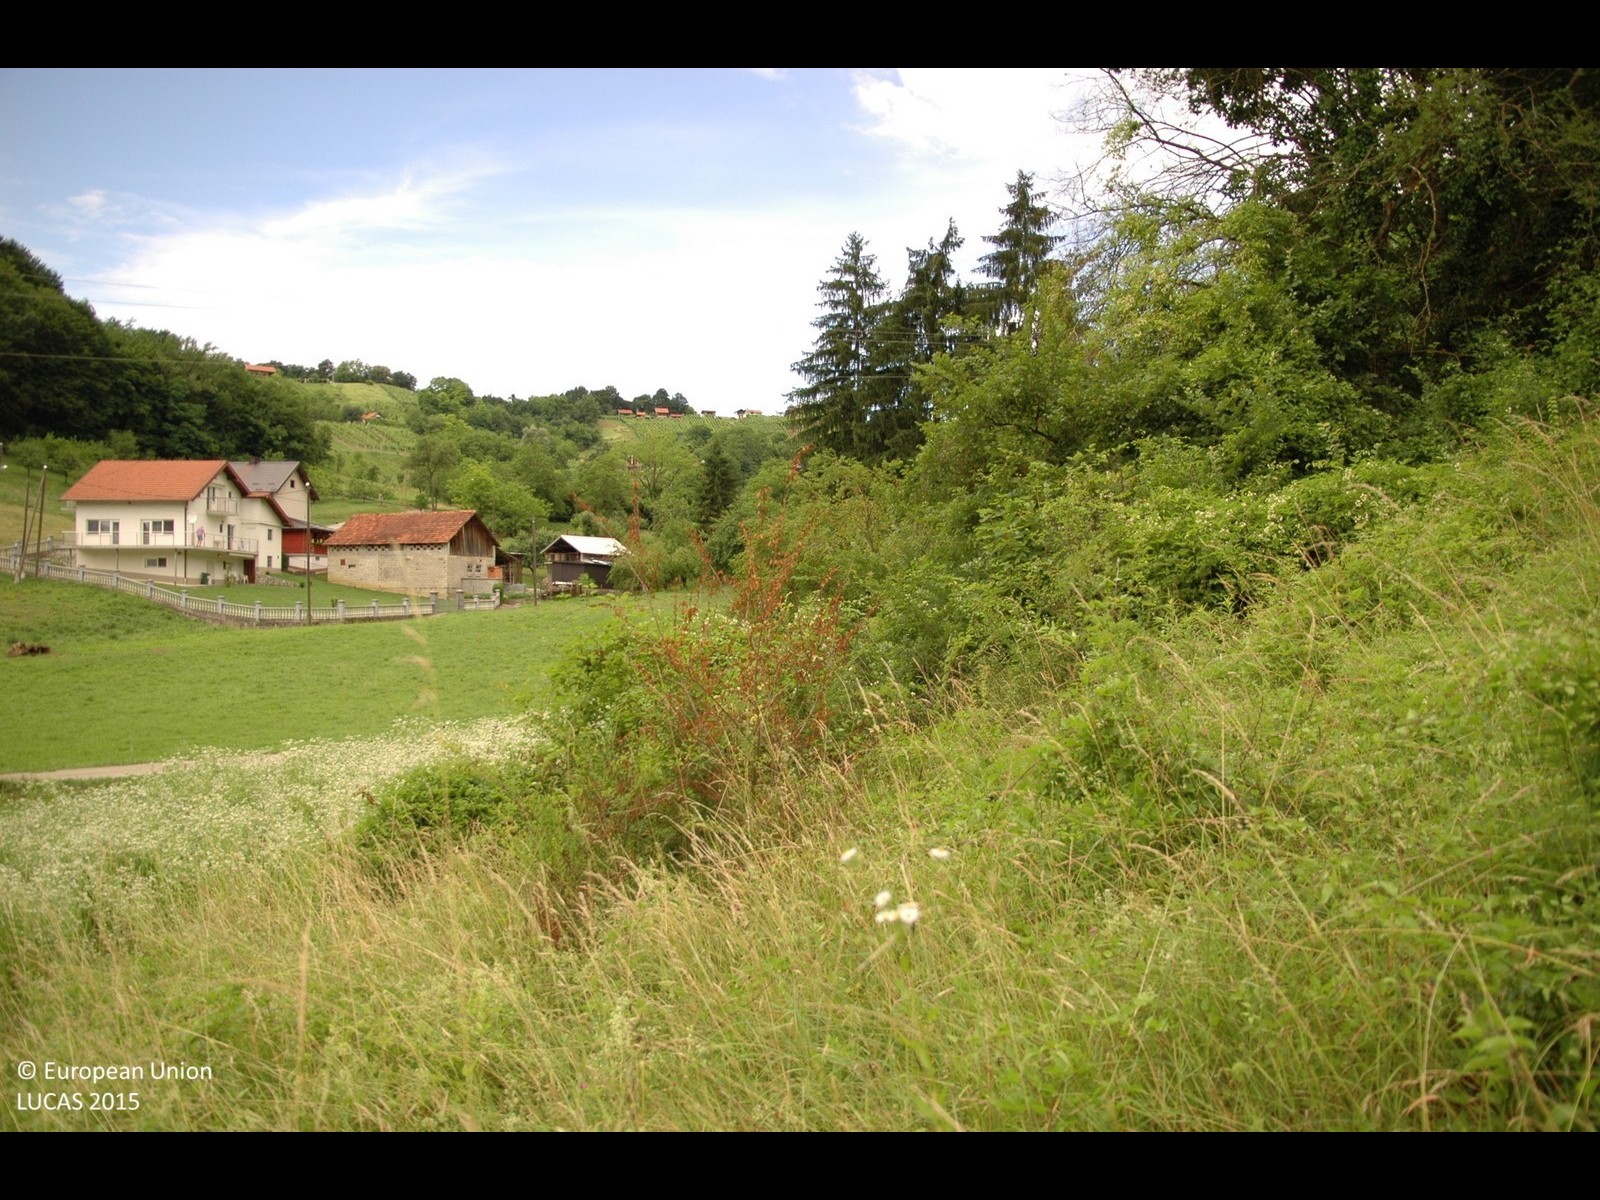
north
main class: Grassland
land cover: Spontaneously vegetated surfaces
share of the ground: > 75 %
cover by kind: herbaceous plants 95 %, shrubs 5 %
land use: Abandoned areas
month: June
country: HR
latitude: 46.0989
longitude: 15.8841
